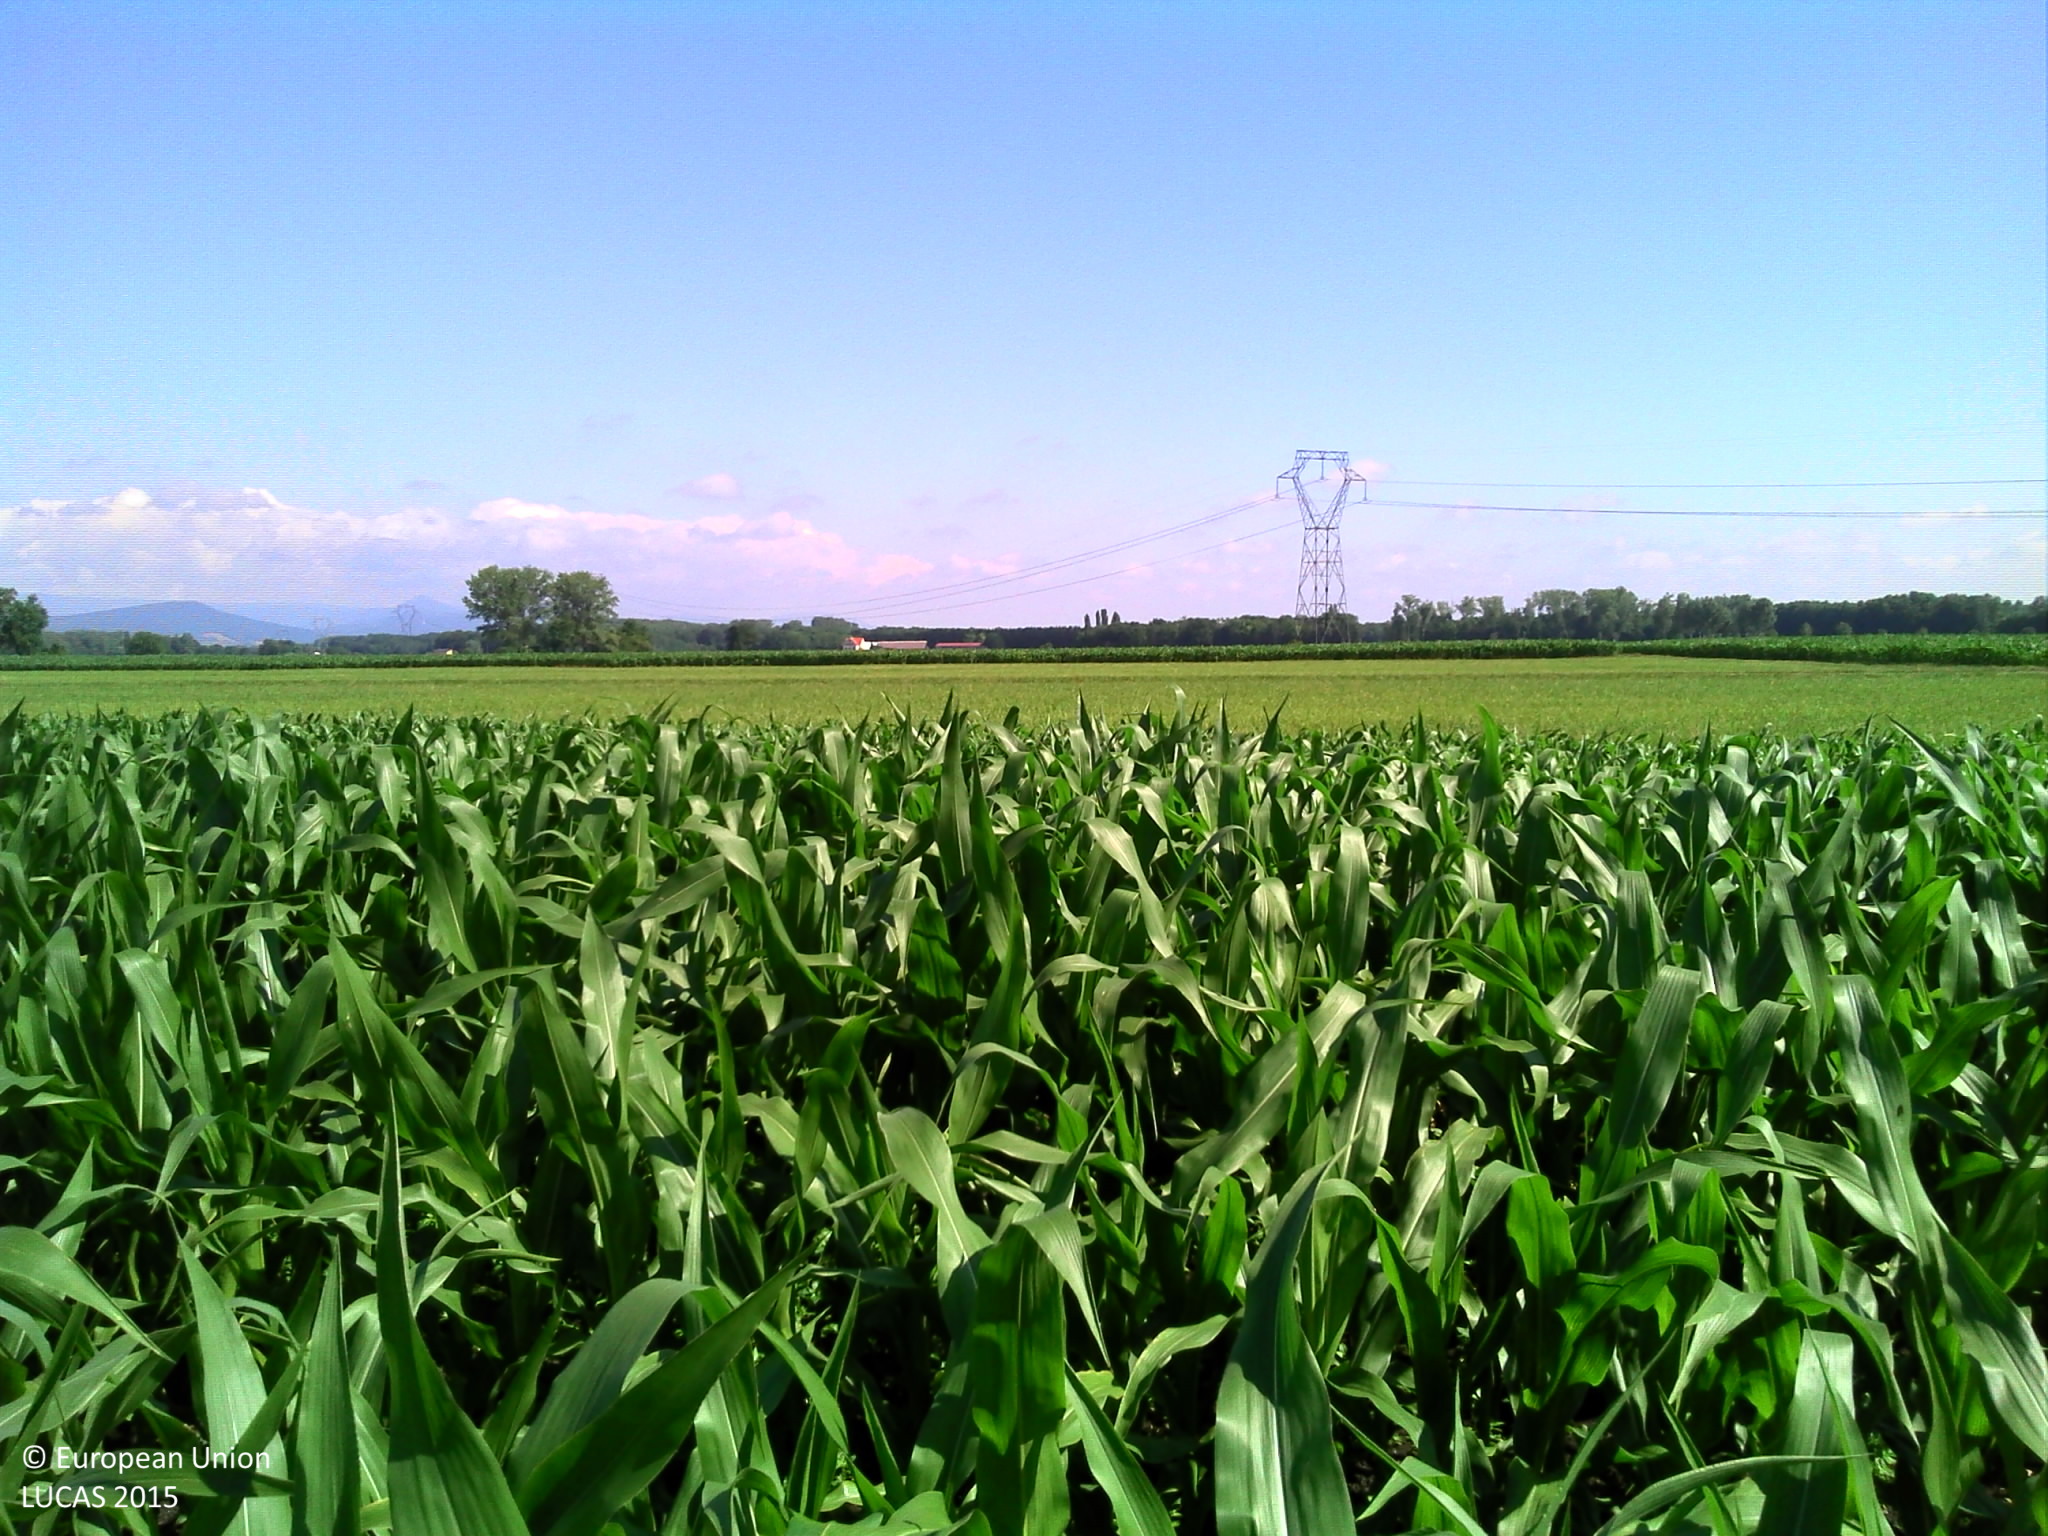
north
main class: Cropland
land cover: Maize
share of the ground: 50 - 75 %
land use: Agriculture (excluding fallow land and kitchen gardens)
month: June
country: FR
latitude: 48.1583
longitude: 7.4602
